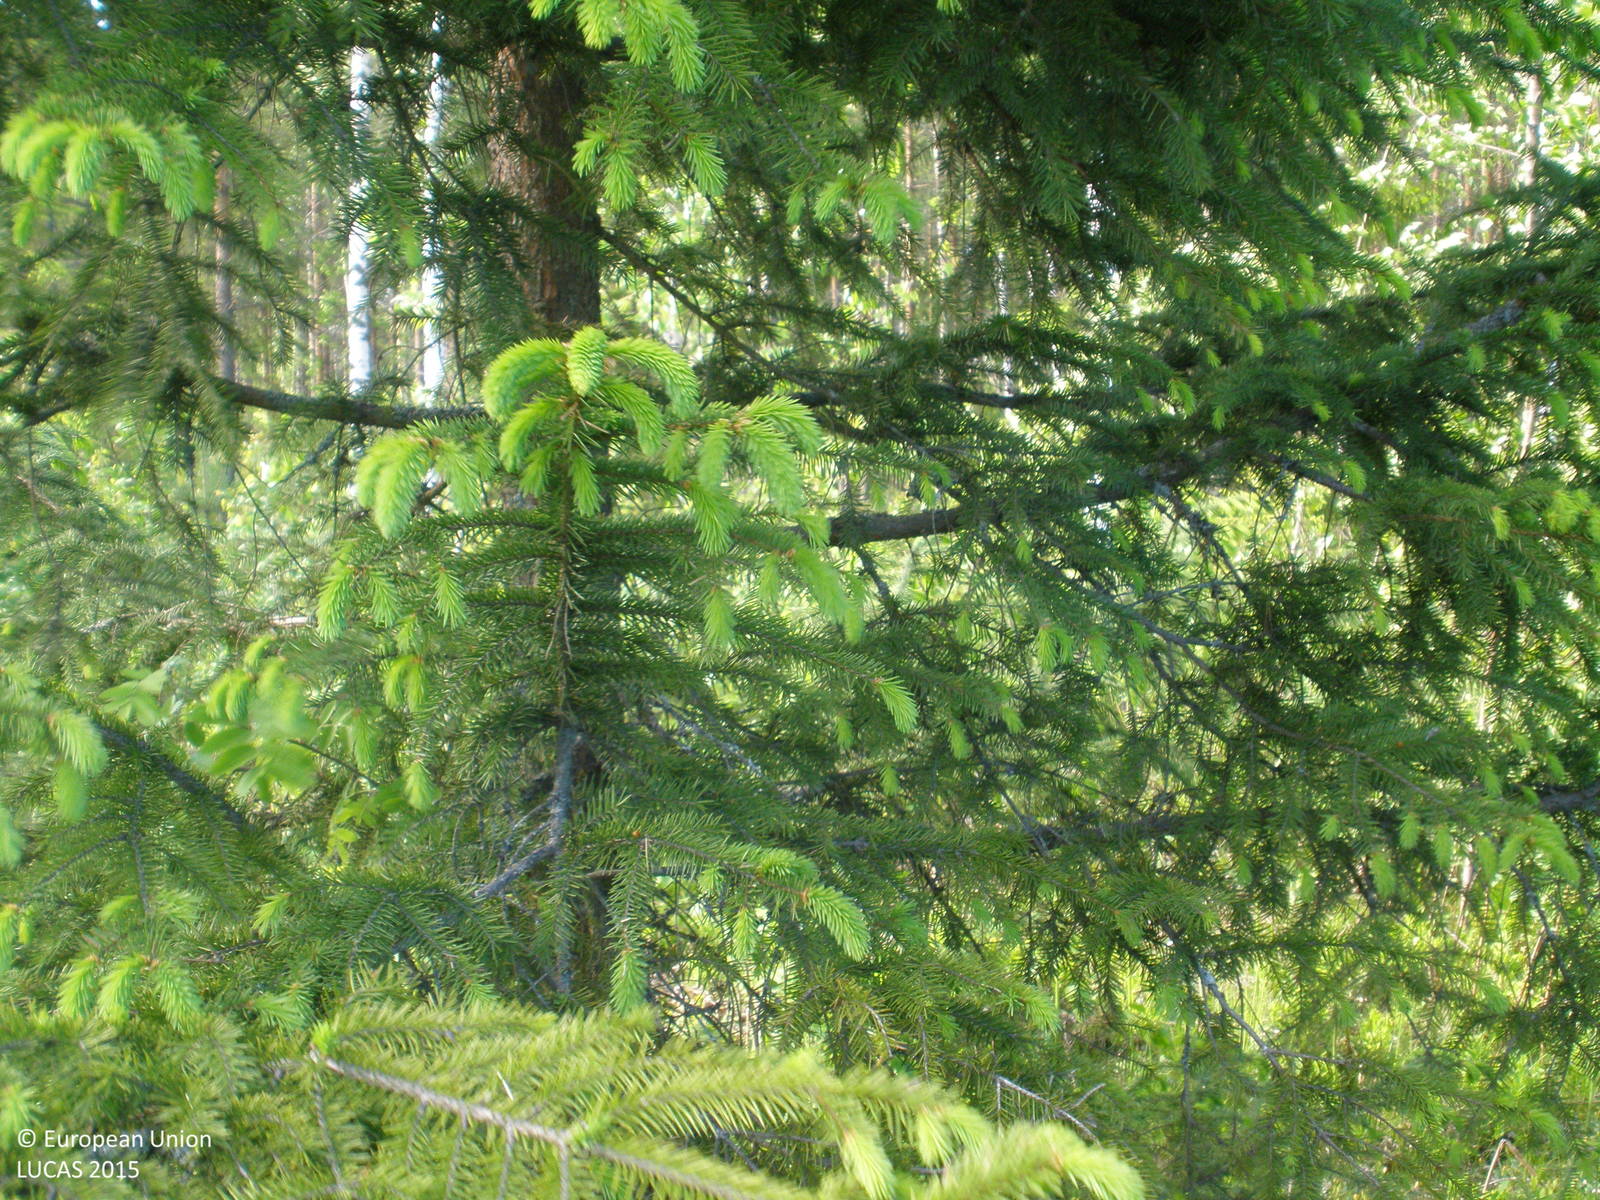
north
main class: Woodland
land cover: Spruce dominated mixed woodland
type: boreal forest
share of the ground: 50 - 75 %
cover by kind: coniferous forest trees 40 %, broadleaved forest trees 25 %, herbaceous plants 20 %, lichens and mosses 10 %, shrubs 5 %
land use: Forestry
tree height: > 5 m
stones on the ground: < 10 %
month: June
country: FI
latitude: 60.8039
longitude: 23.5565
